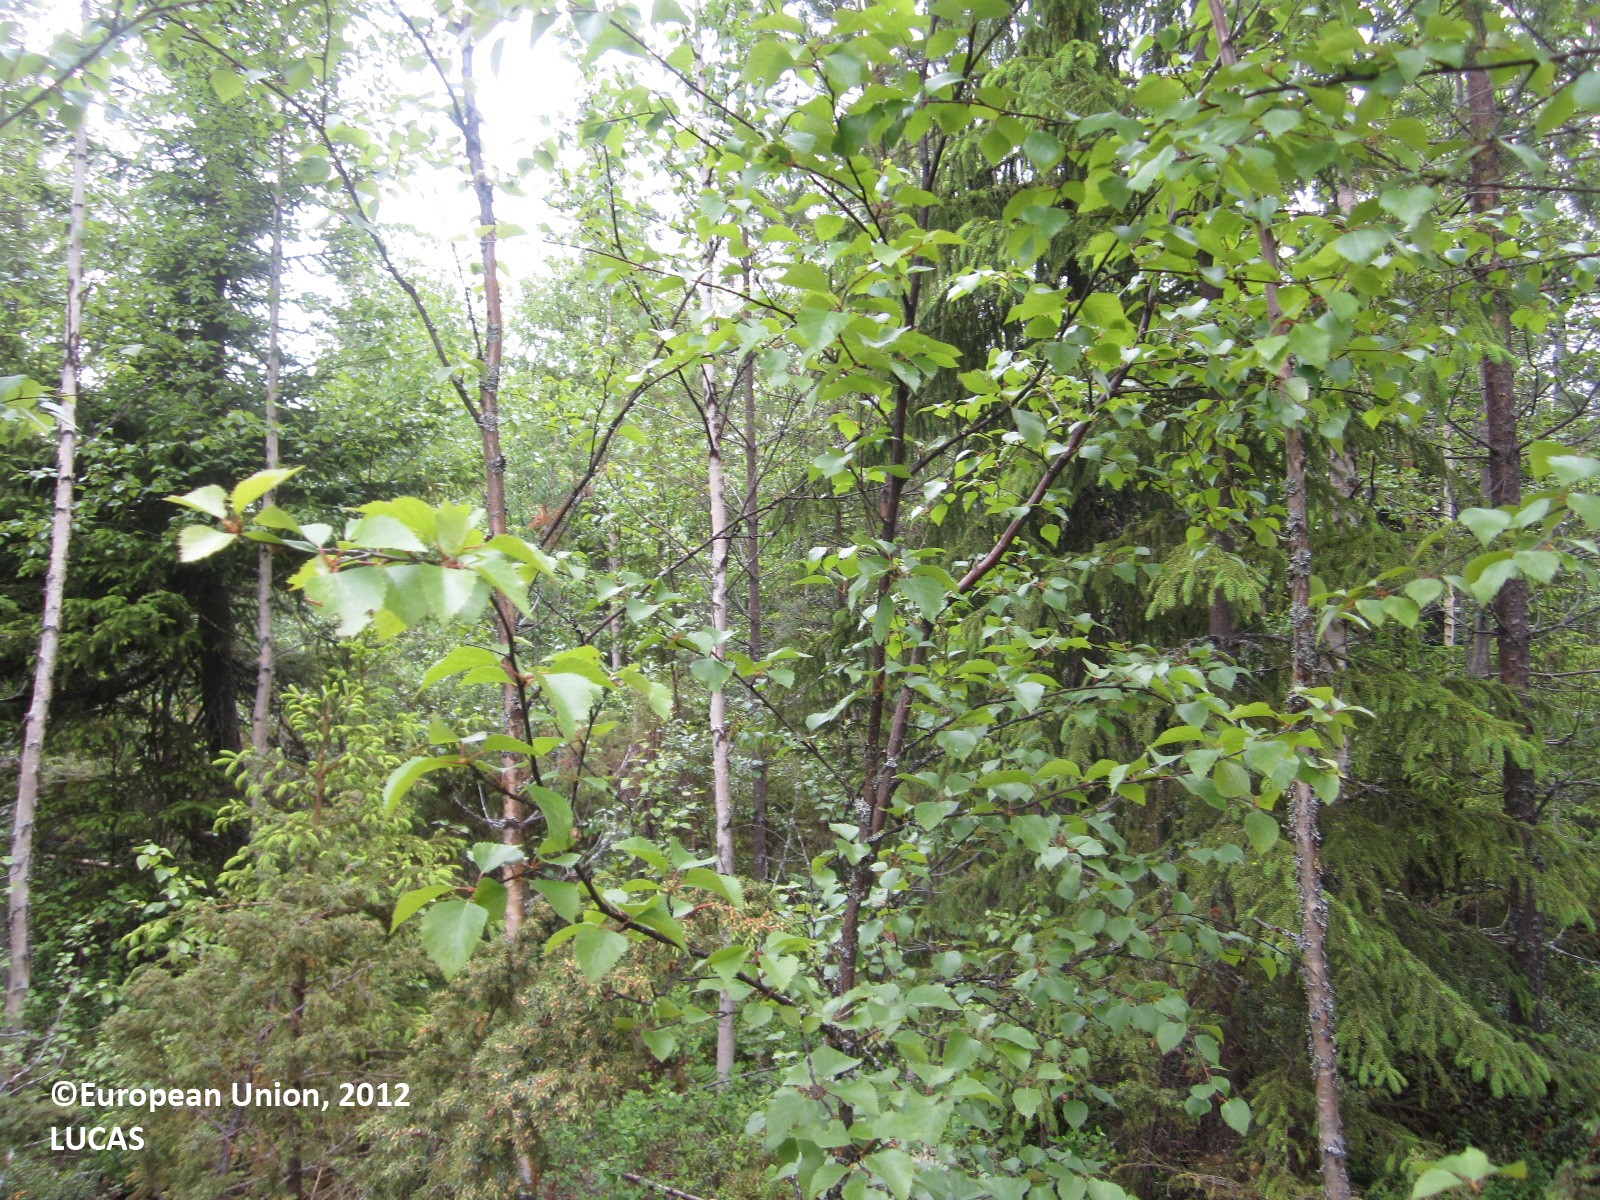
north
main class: Woodland
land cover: Pine dominated mixed woodland
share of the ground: 50 - 75 %
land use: Forestry
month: June
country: FI
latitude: 64.6646
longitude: 29.6755
